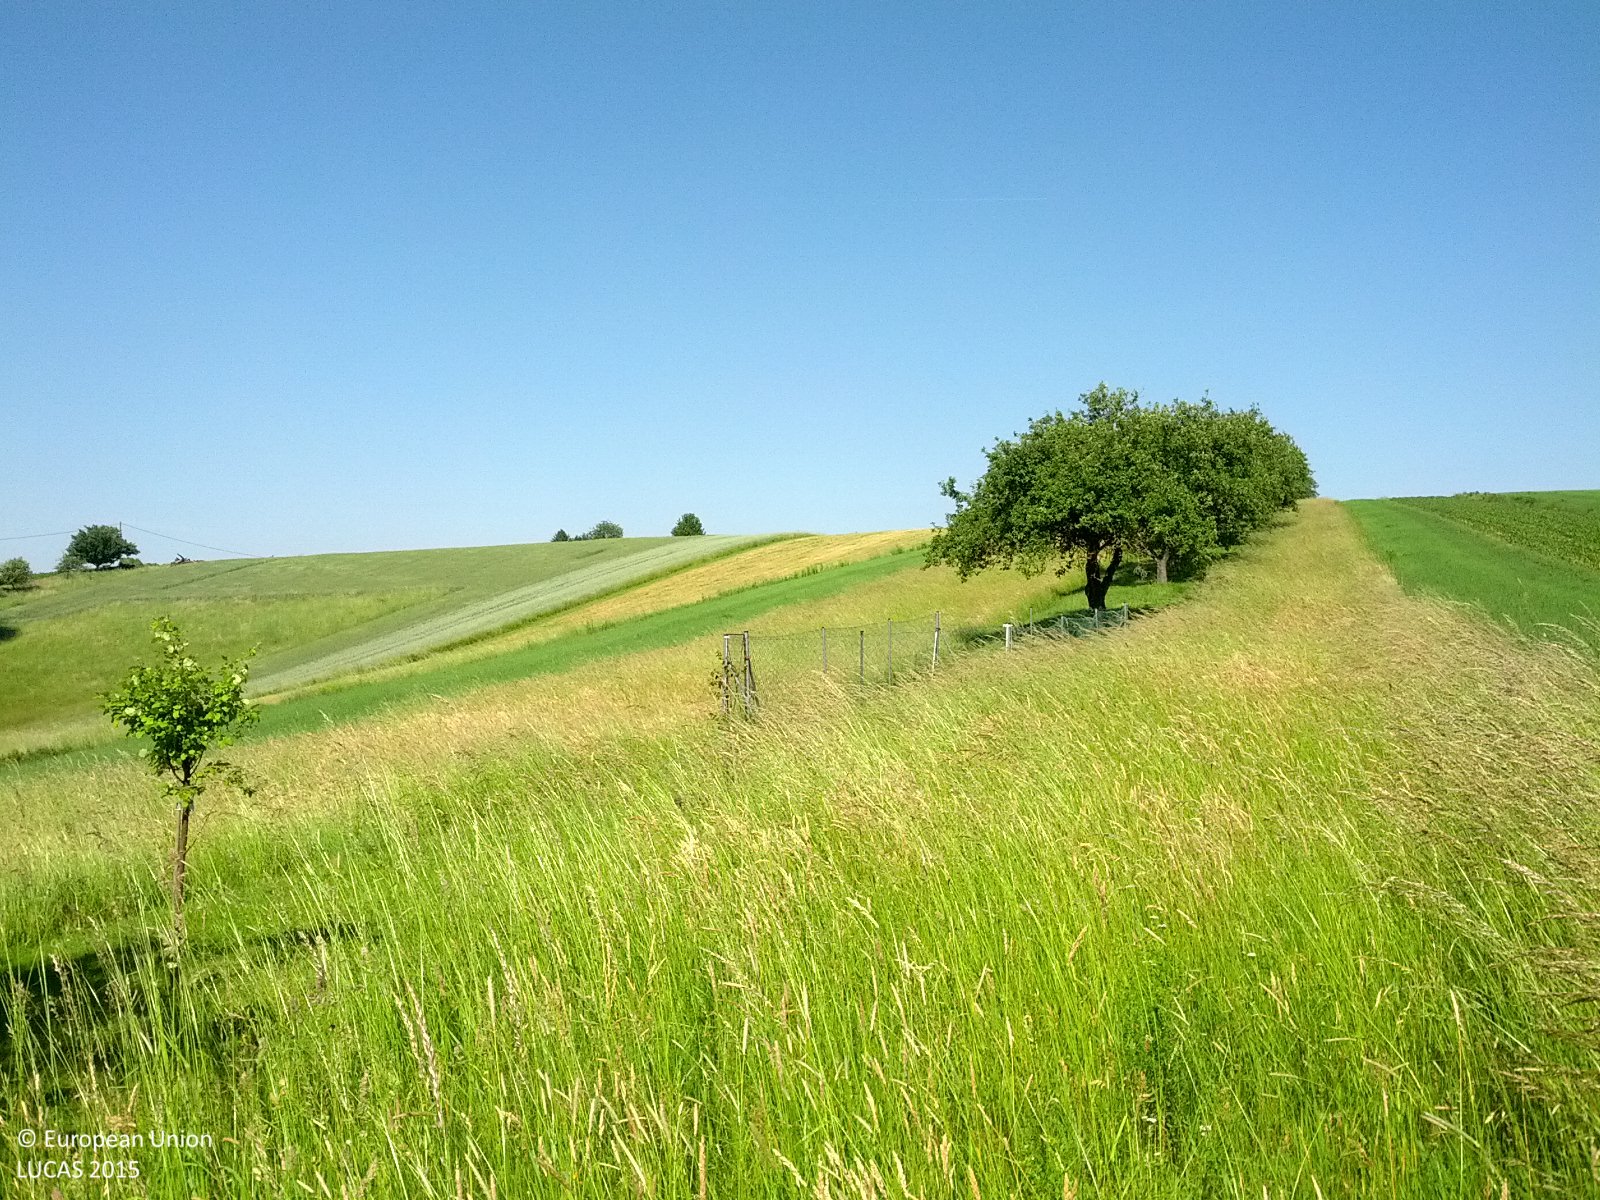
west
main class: Grassland
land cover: Grassland without tree/shrub cover
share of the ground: > 75 %
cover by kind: herbaceous plants 100 %
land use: Agriculture (excluding fallow land and kitchen gardens)
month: June
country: AT
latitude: 47.1861
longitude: 16.1384
